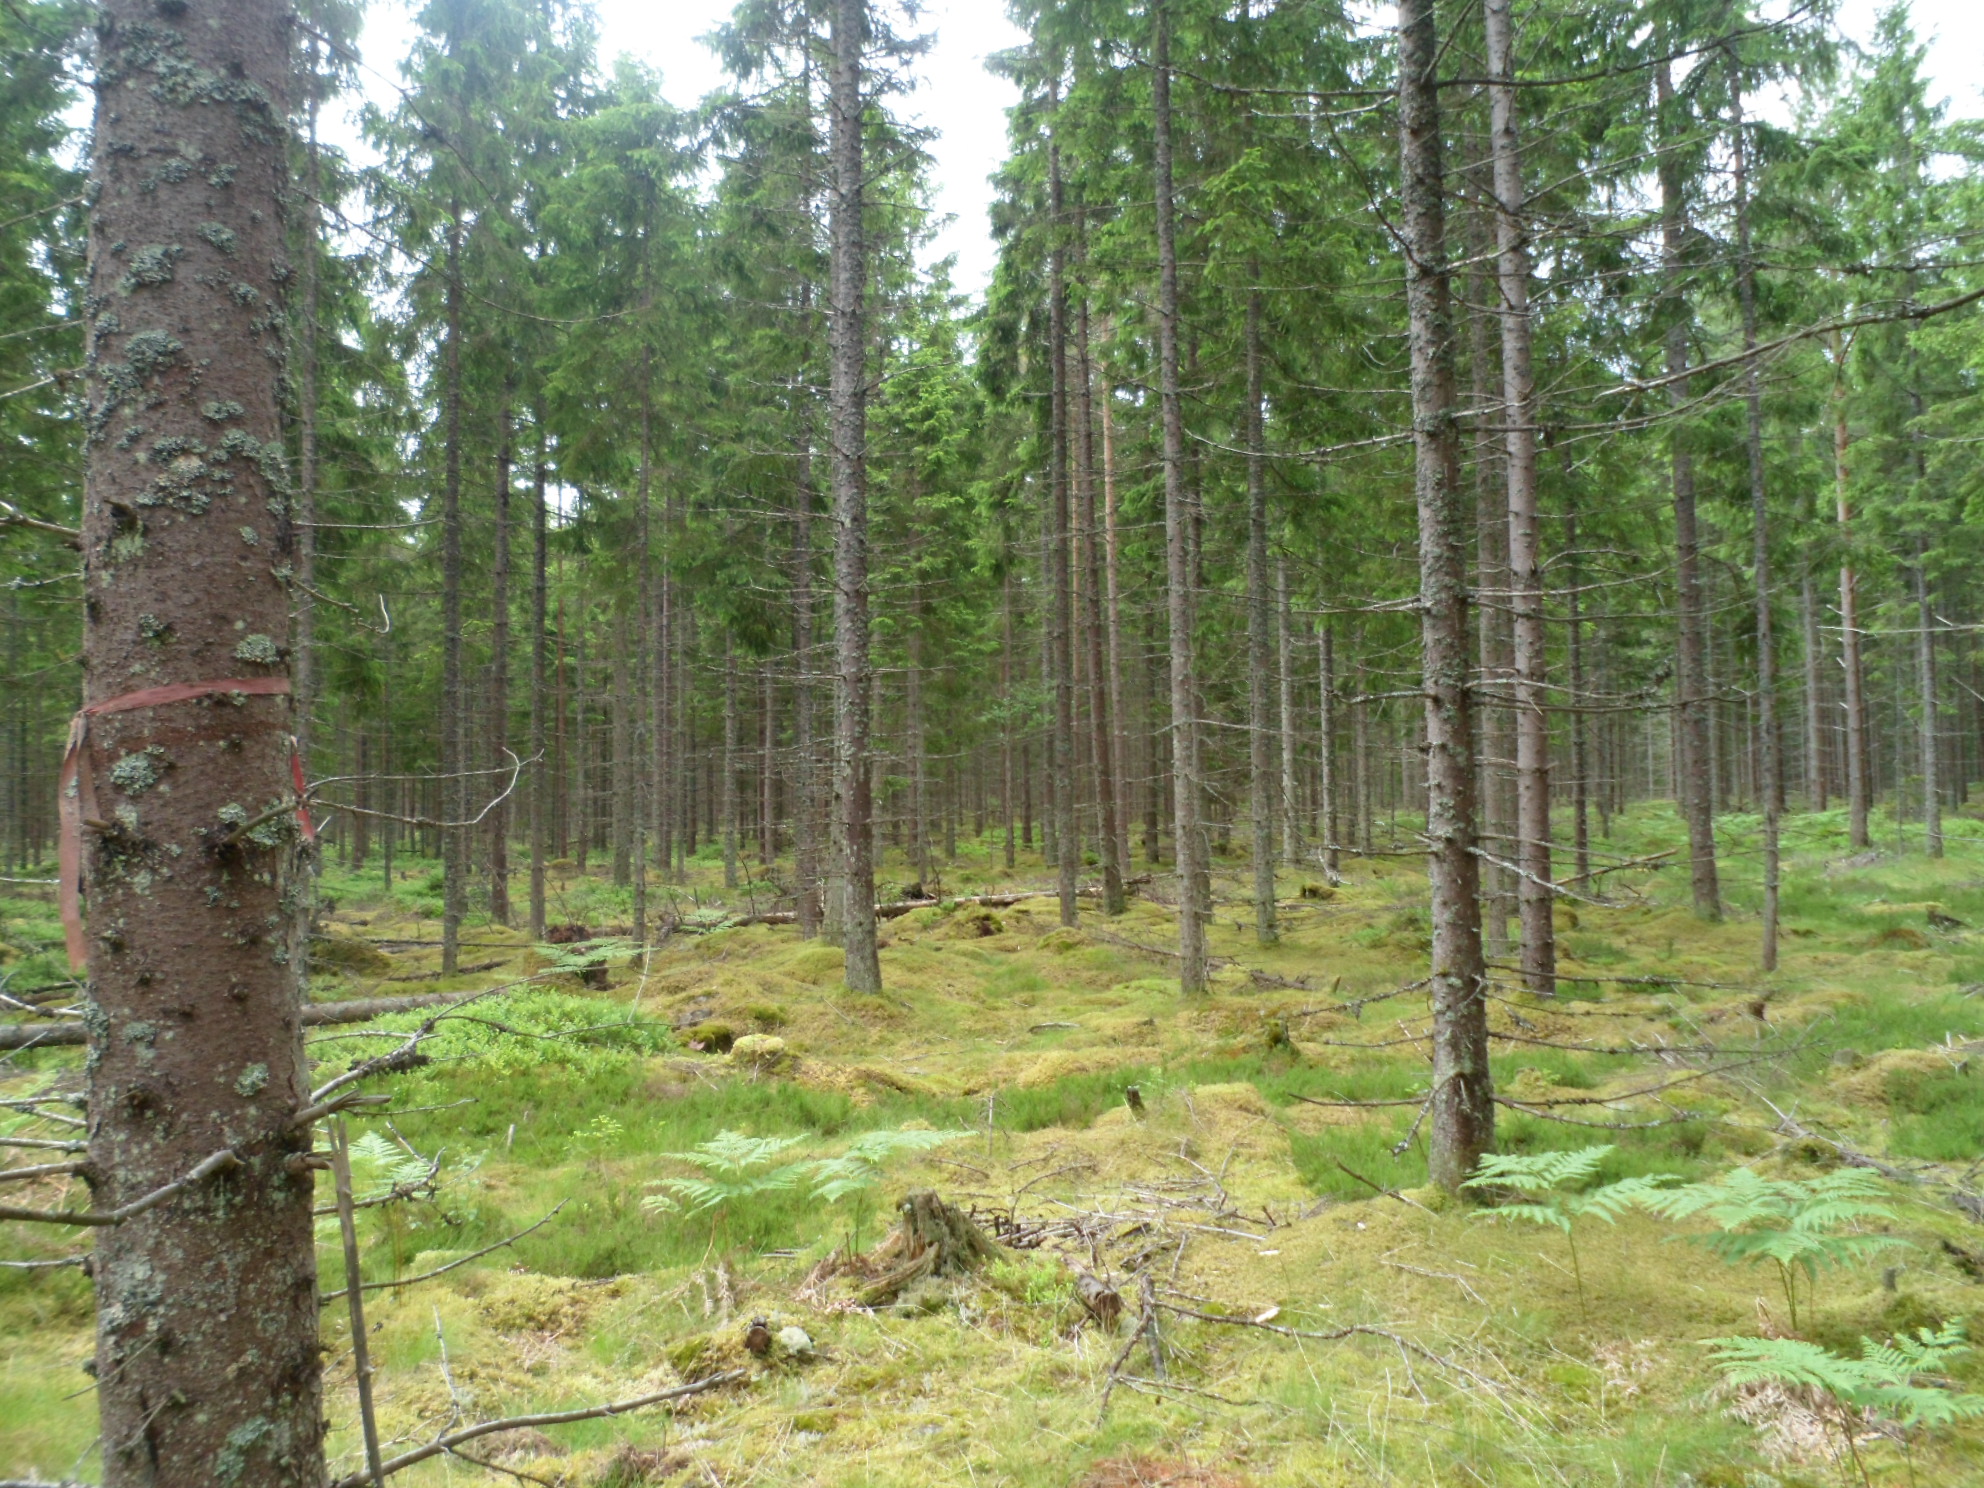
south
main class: Woodland
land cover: Spruce dominated coniferous woodland
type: boreal forest
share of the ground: 50 - 75 %
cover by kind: coniferous forest trees 55 %, lichens and mosses 30 %, shrubs 10 %, herbaceous plants 5 %
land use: Forestry
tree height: > 5 m
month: June
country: SE
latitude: 57.0546
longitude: 15.2237
